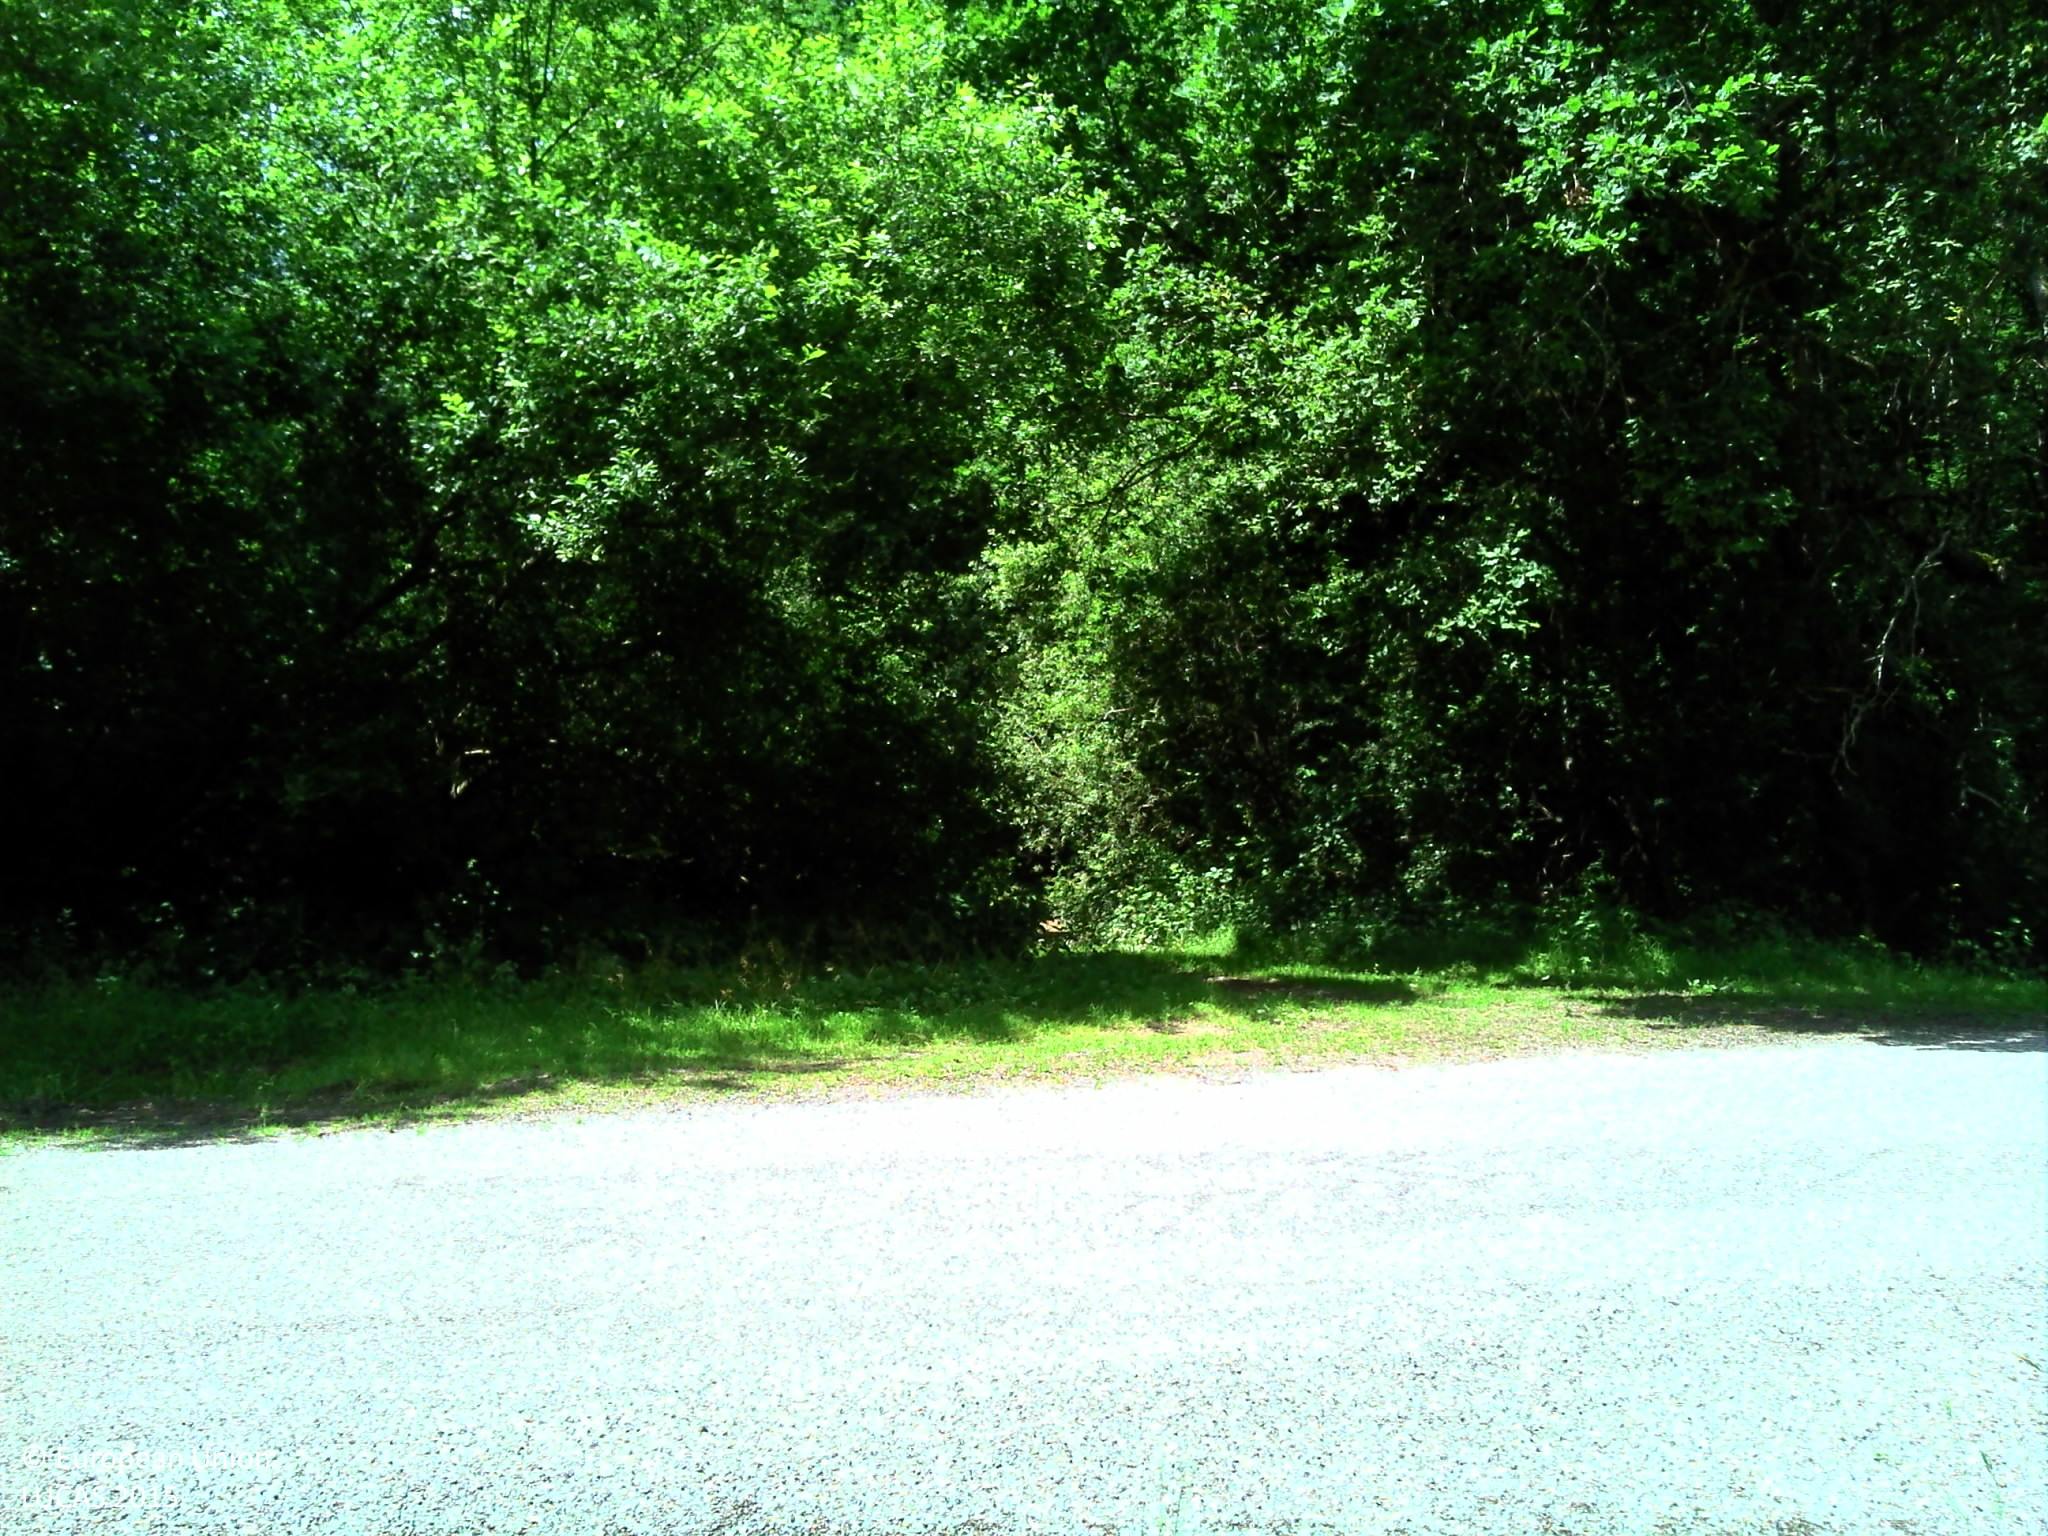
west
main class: Woodland
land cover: Pine dominated mixed woodland
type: acidophilous oak and oak-birch forest
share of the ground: > 75 %
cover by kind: broadleaved forest trees 60 %, coniferous forest trees 25 %, shrubs 10 %, herbaceous plants 5 %
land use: Forestry
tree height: > 5 m
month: June
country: FR
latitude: 46.1787
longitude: 3.0419
